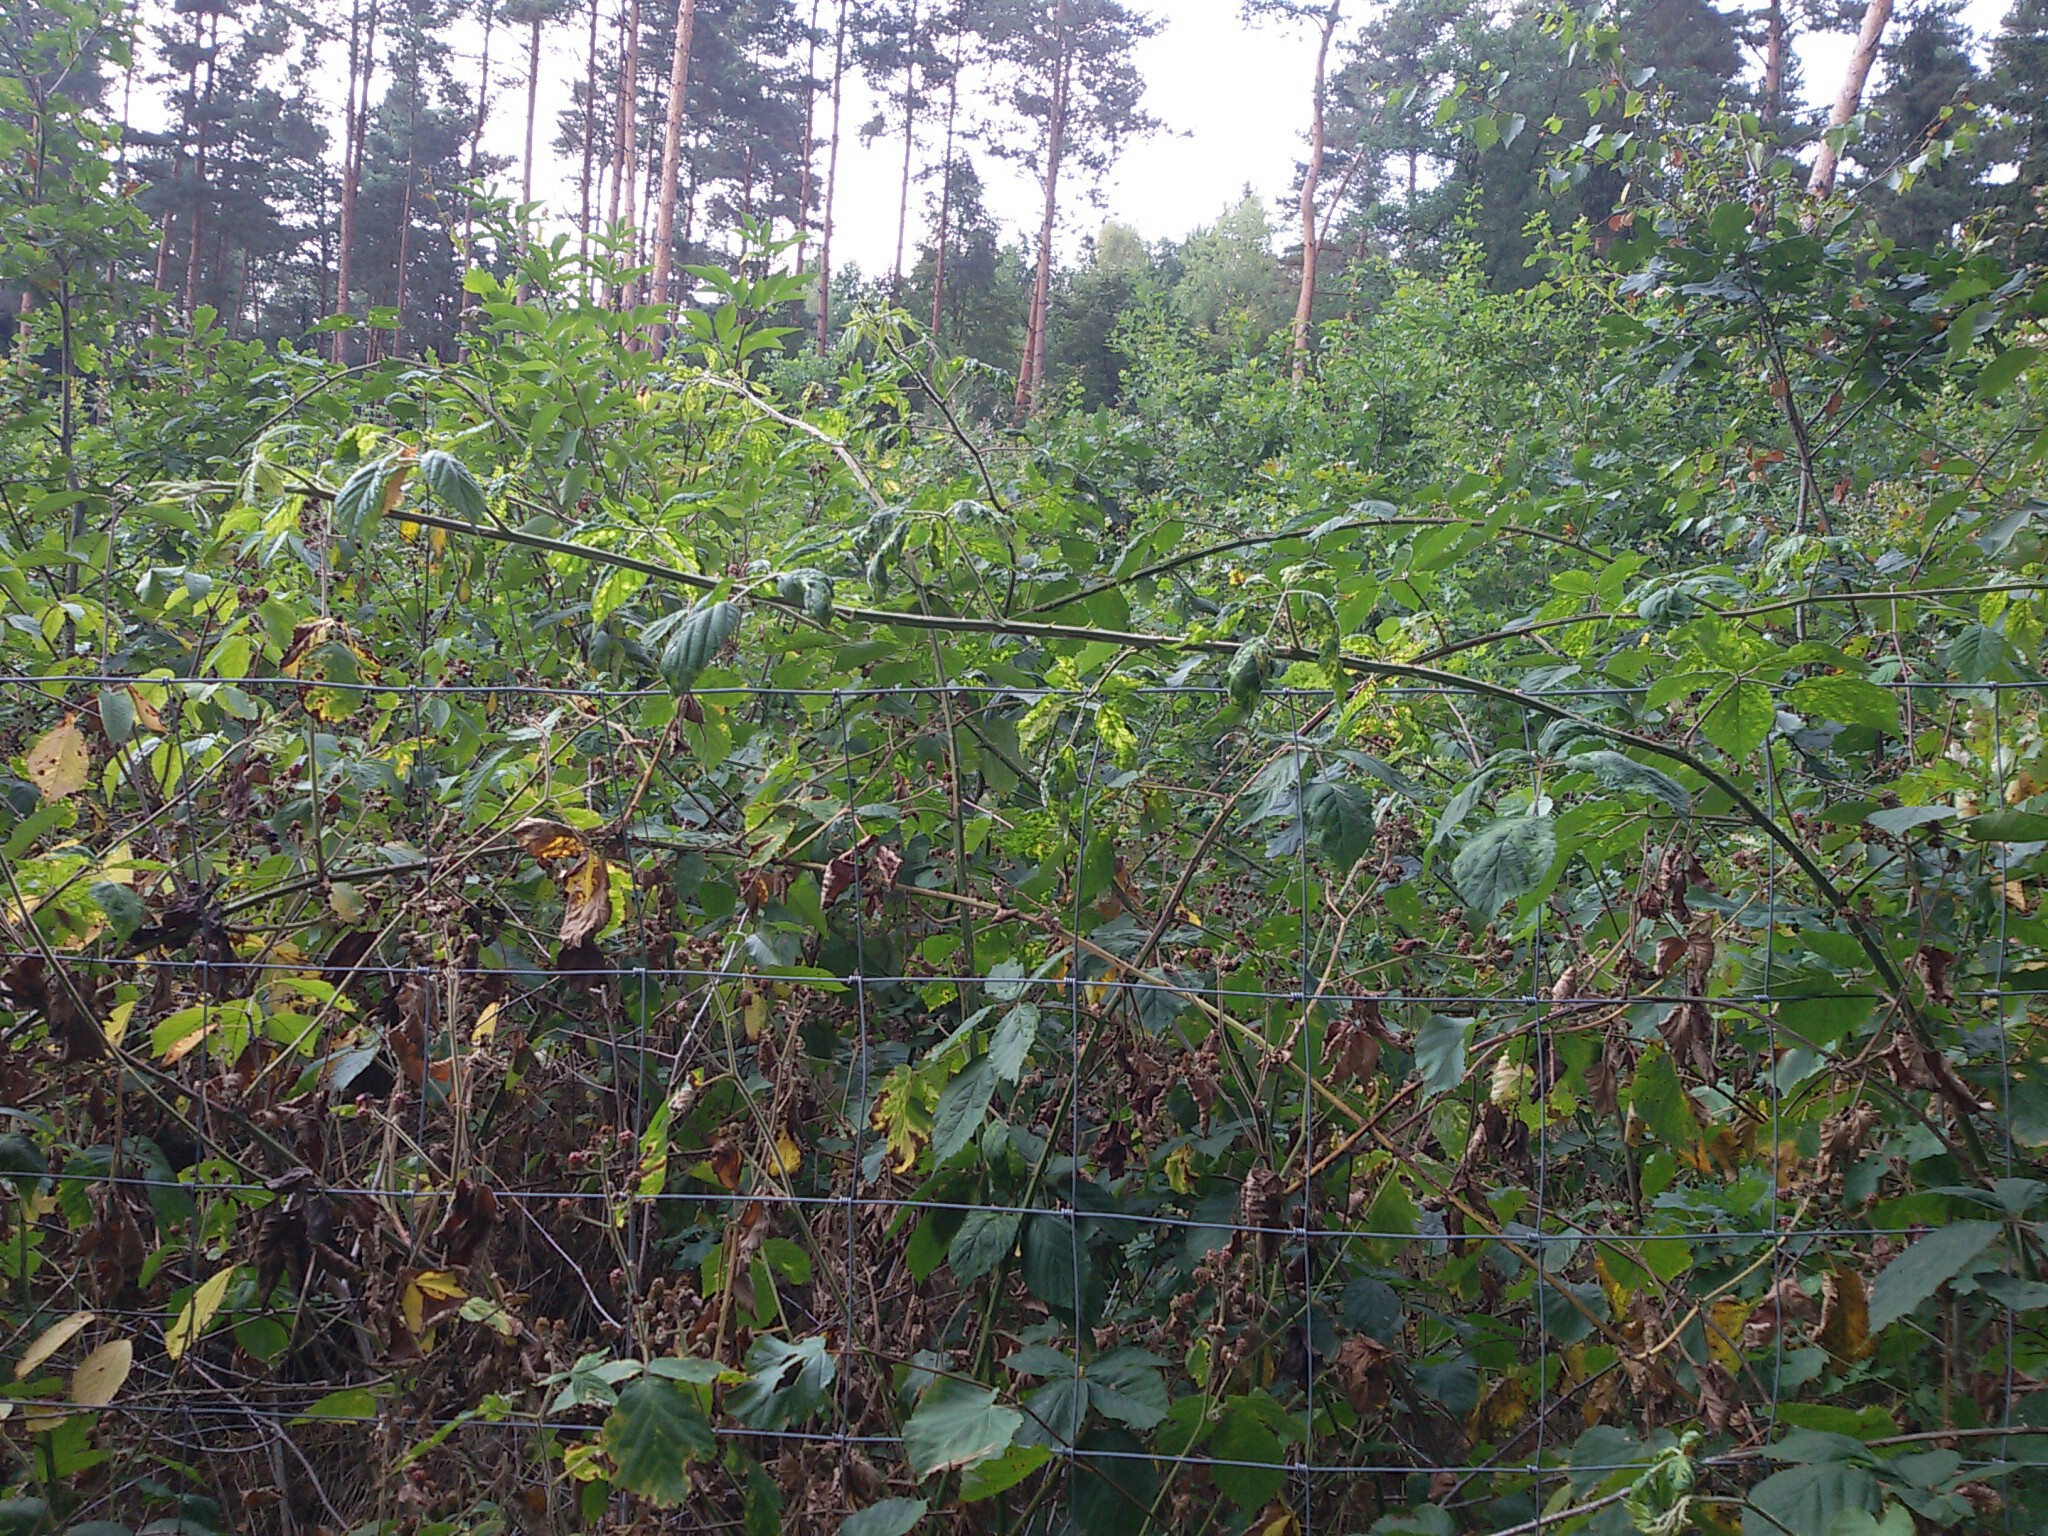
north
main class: Woodland
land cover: Broadleaved woodland
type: mesophytic deciduous forest
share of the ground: > 75 %
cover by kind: broadleaved forest trees 90 %, shrubs 5 %, herbaceous plants 5 %
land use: Forestry
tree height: < 5 m
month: August
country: PL
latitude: 51.1229
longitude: 15.7056
